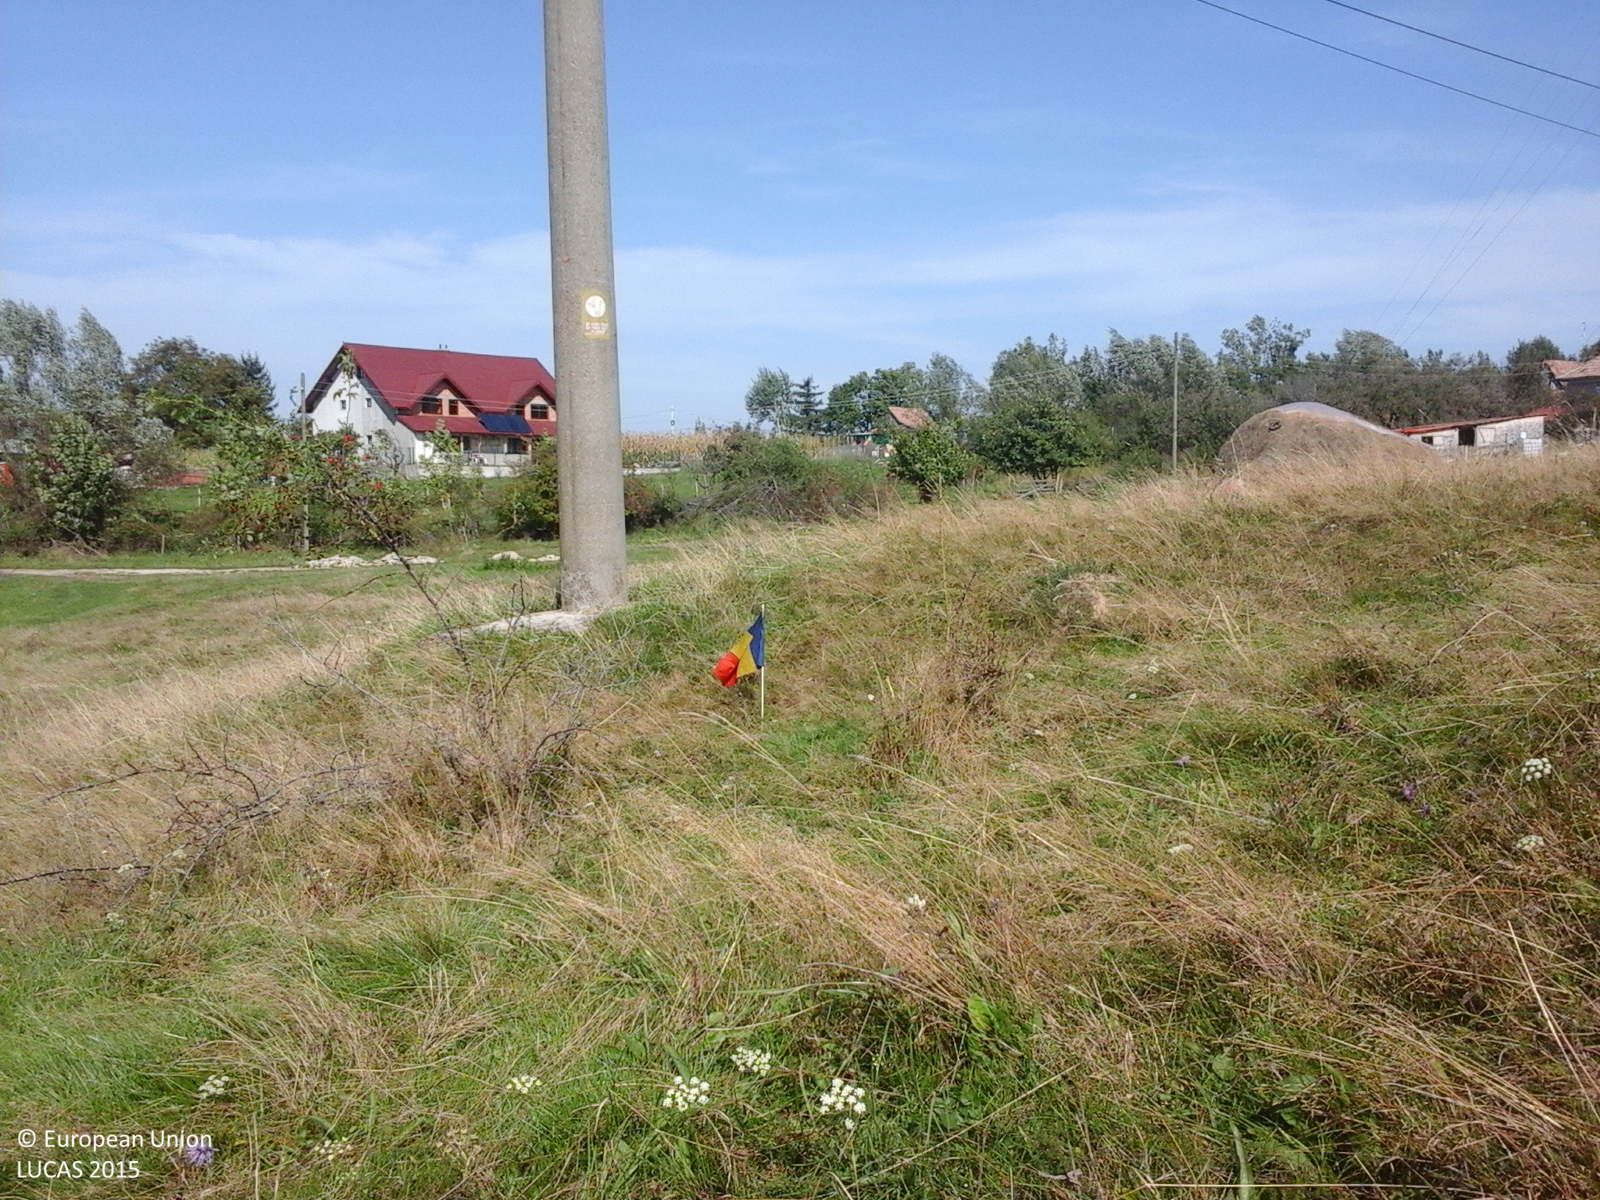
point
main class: Grassland
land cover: Grassland without tree/shrub cover
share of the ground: > 75 %
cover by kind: herbaceous plants 100 %
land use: Agriculture (excluding fallow land and kitchen gardens)
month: September
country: RO
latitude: 46.7142
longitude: 23.6372
